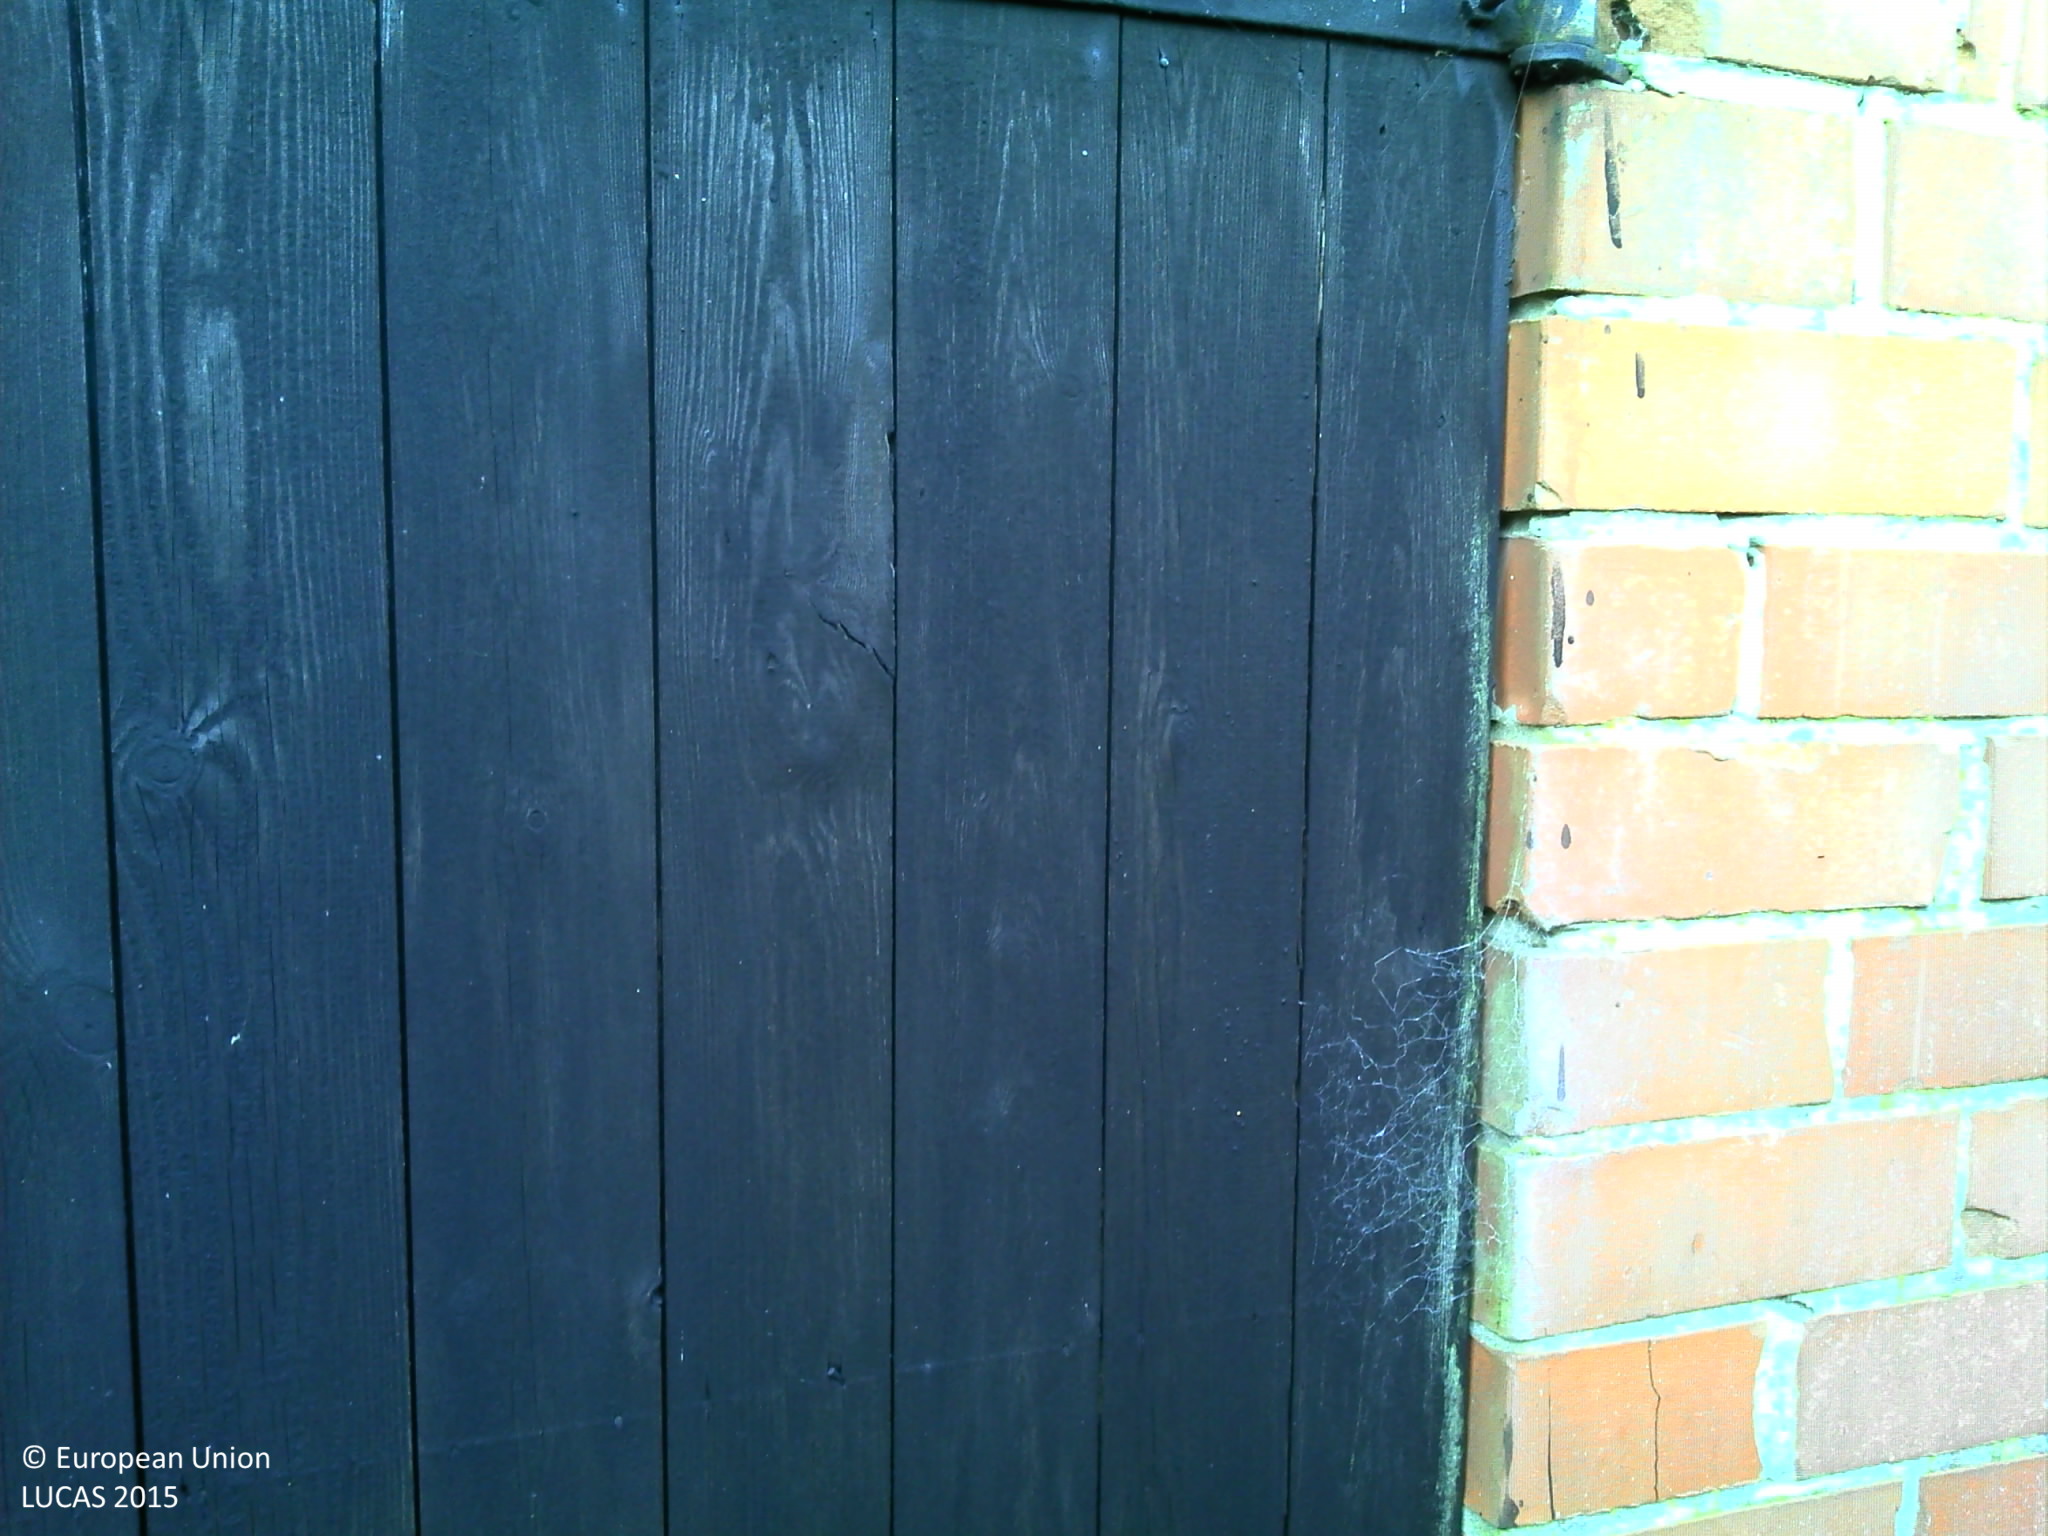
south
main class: Cropland
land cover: Maize
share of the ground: > 75 %
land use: Agriculture (excluding fallow land and kitchen gardens)
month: September
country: BE
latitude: 51.4206
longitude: 4.4880
